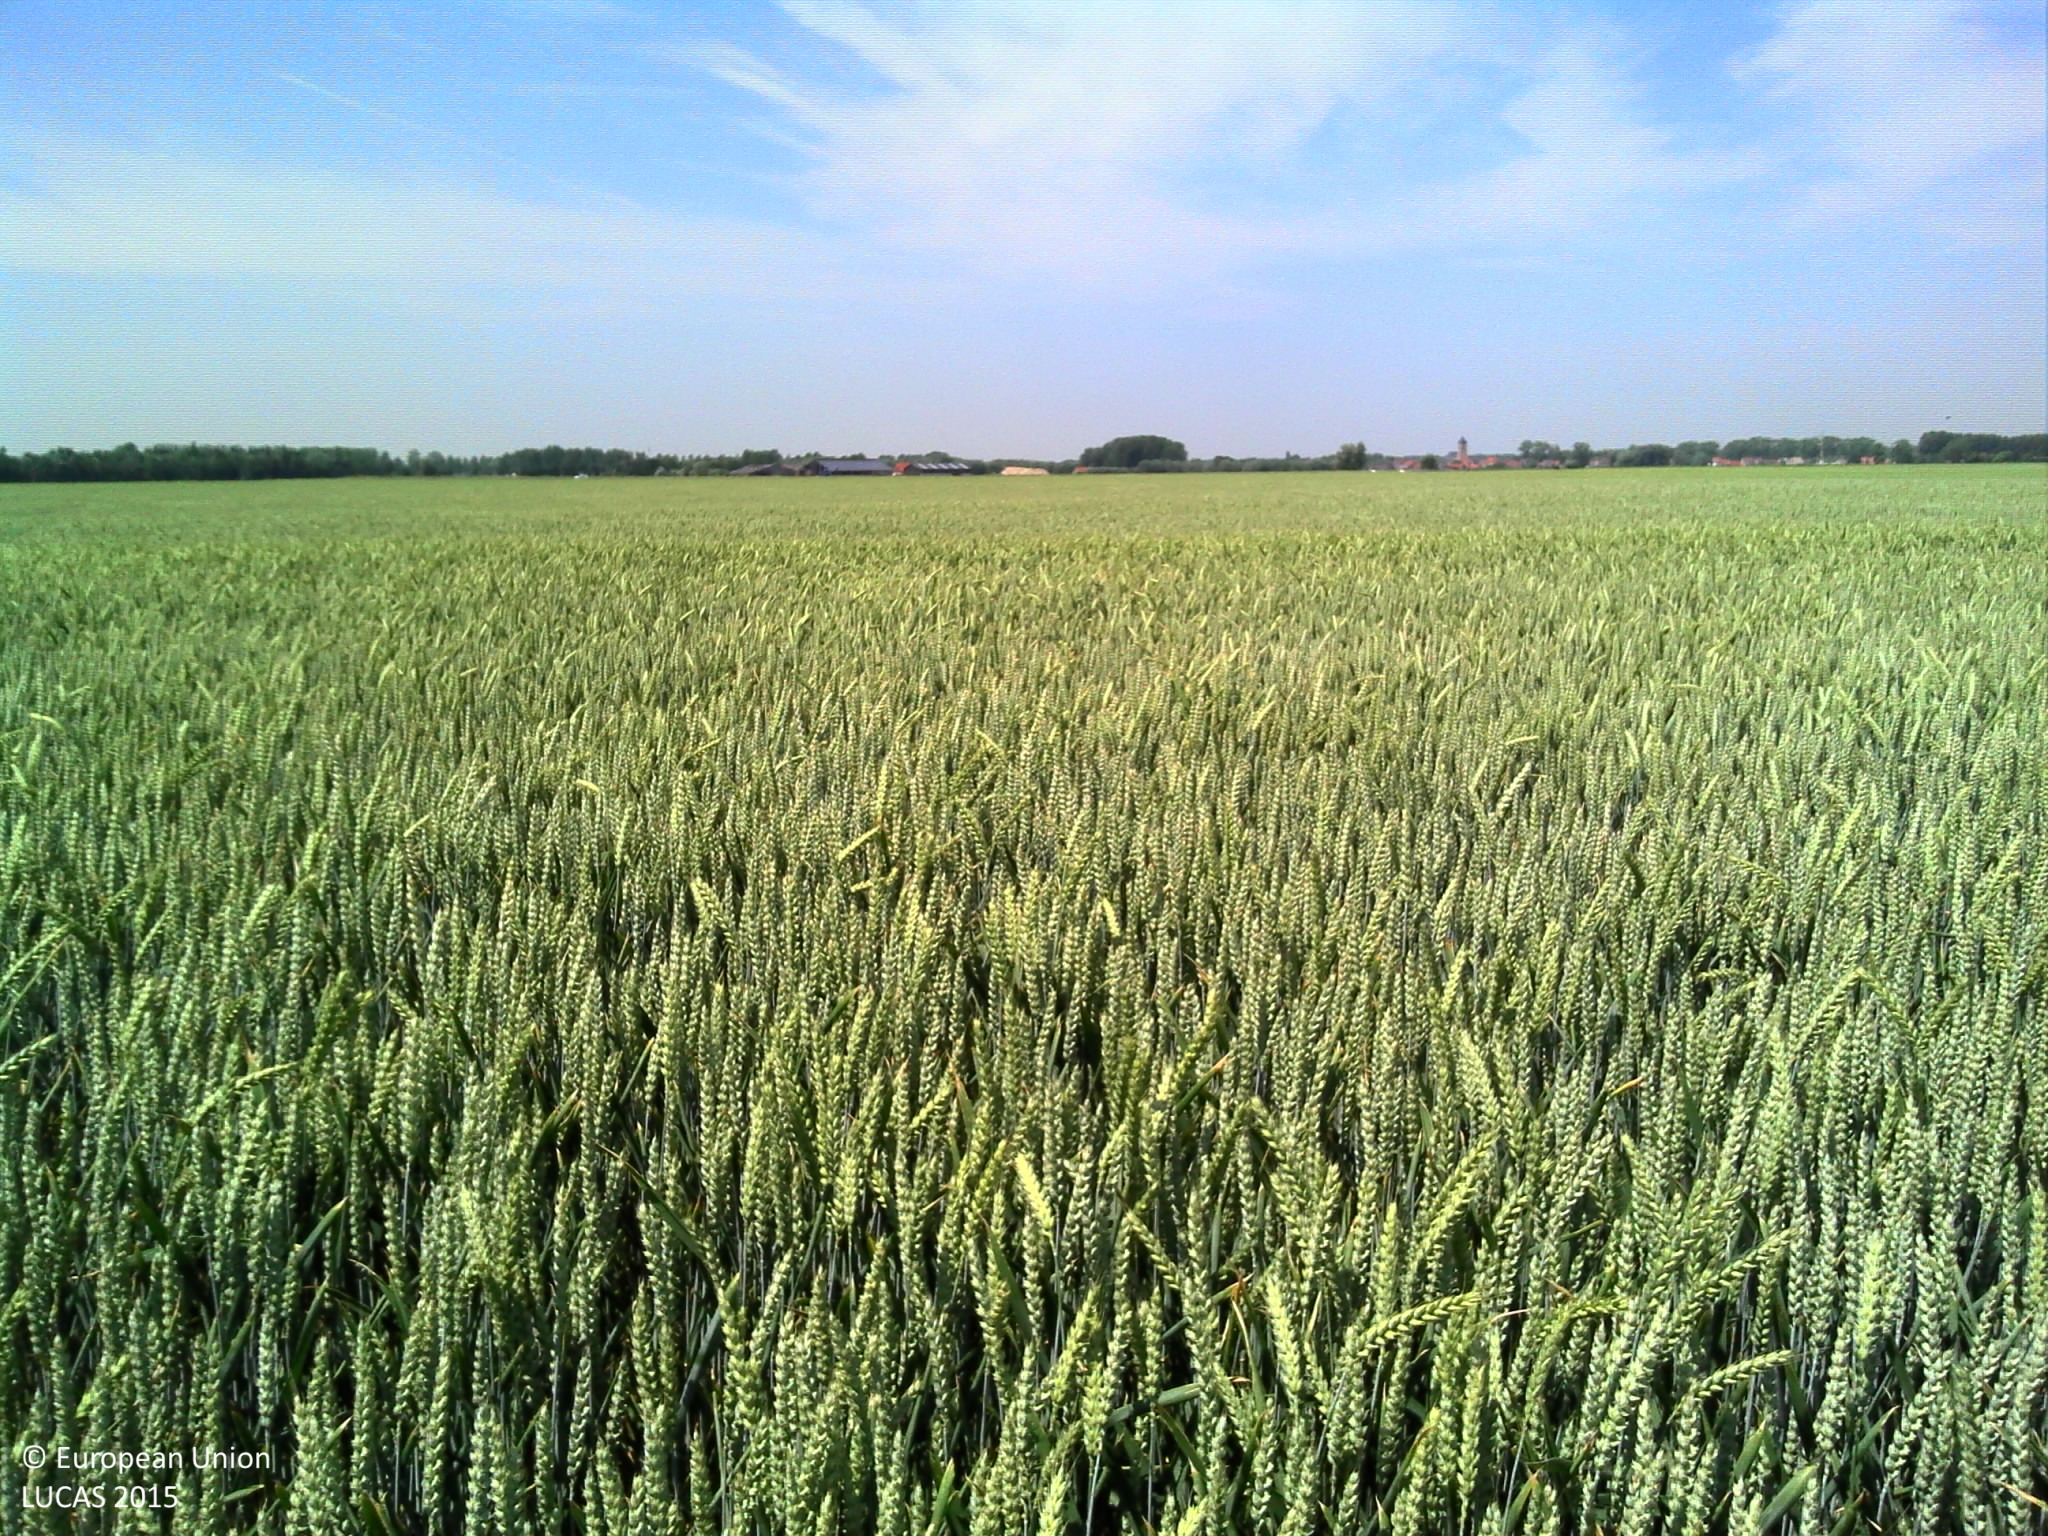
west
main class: Cropland
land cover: Common wheat
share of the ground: > 75 %
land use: Agriculture (excluding fallow land and kitchen gardens)
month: July
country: BE
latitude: 51.2729
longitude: 3.3836
